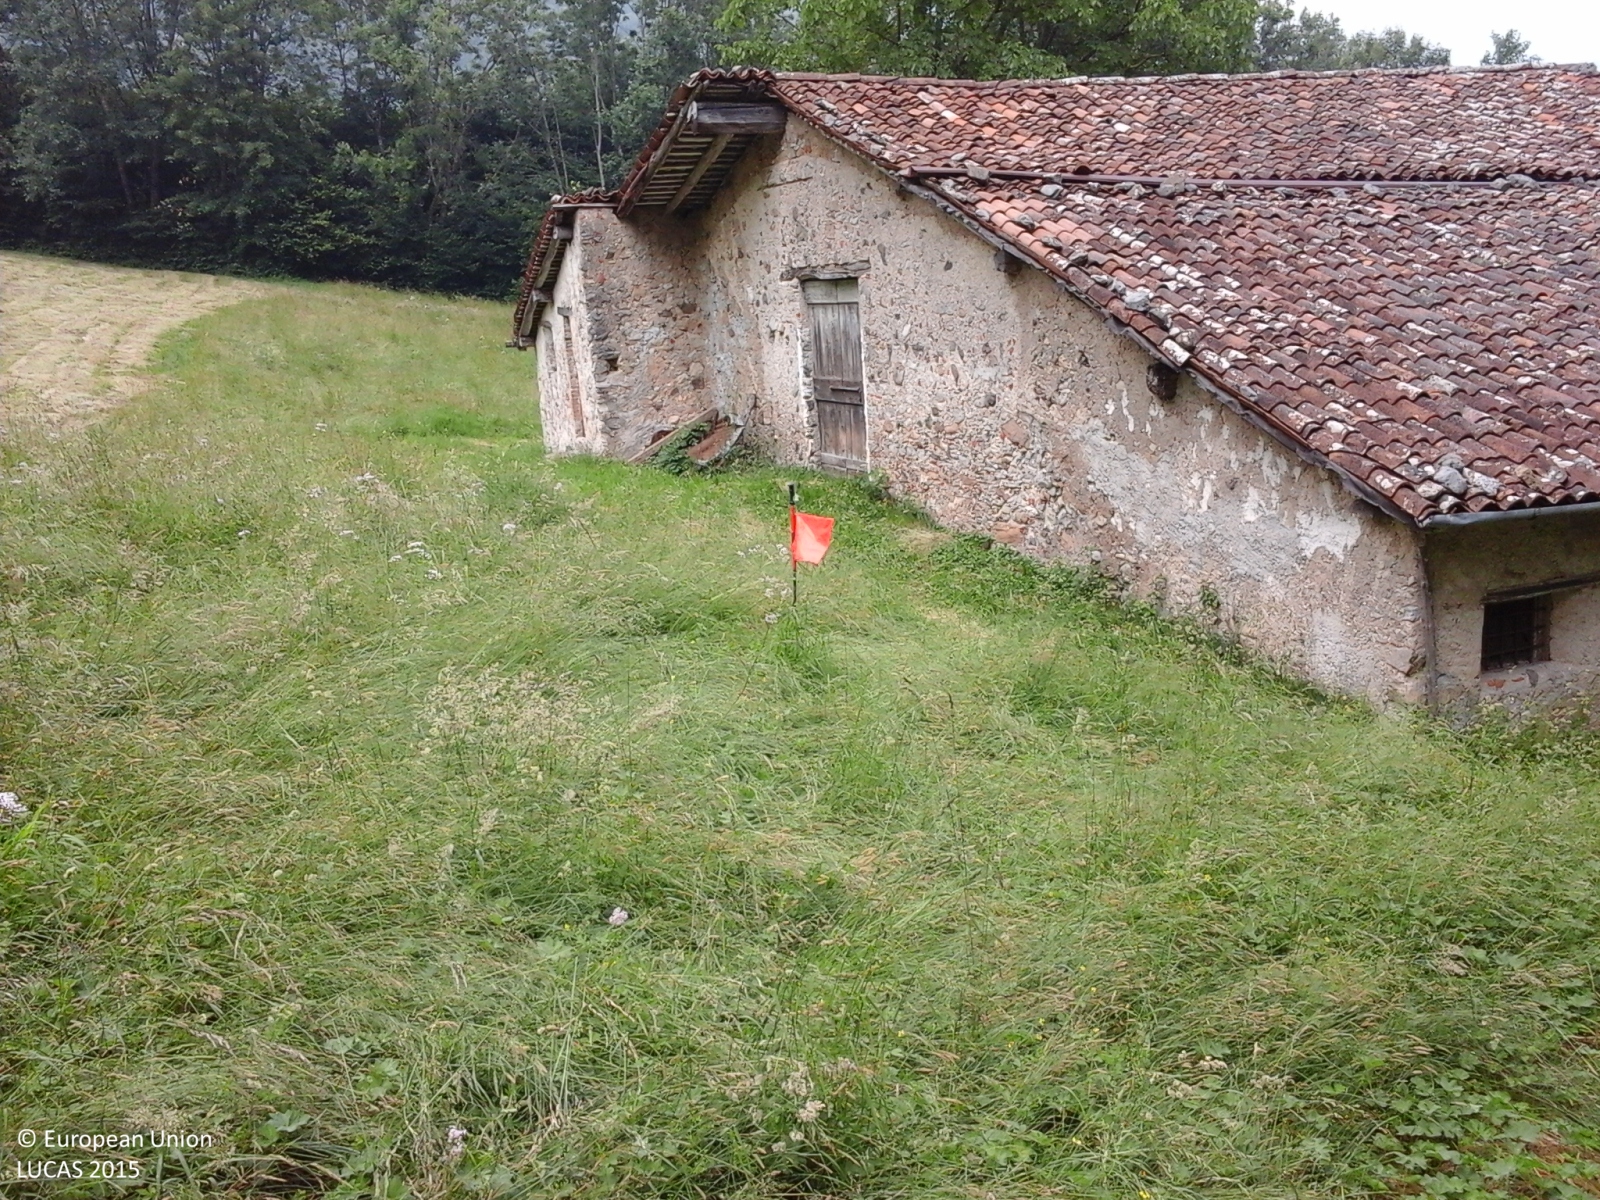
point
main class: Grassland
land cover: Grassland without tree/shrub cover
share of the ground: > 75 %
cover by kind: herbaceous plants 100 %
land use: Agriculture (excluding fallow land and kitchen gardens)
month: June
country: IT
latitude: 45.7565
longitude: 10.2182
